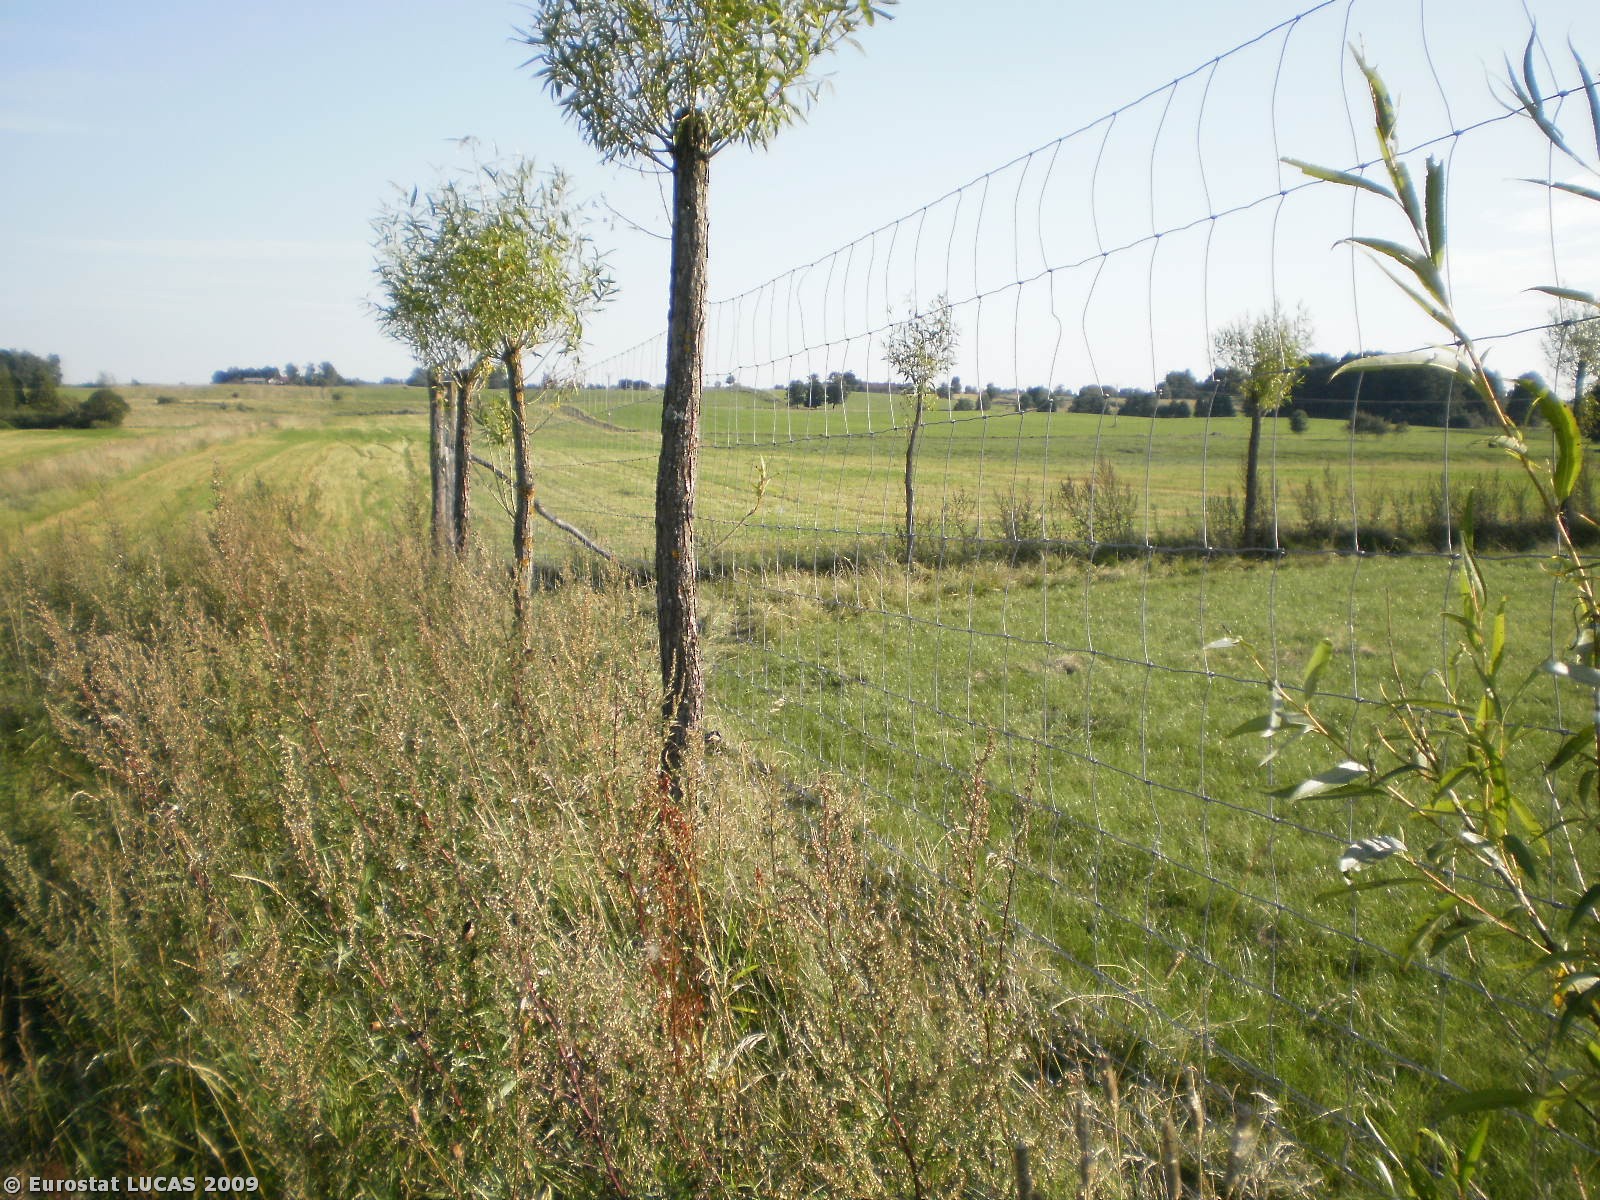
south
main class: Grassland
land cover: Grassland without tree/shrub cover
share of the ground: > 75 %
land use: Agriculture (excluding fallow land and kitchen gardens)
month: August
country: PL
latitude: 54.2913
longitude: 22.2118
